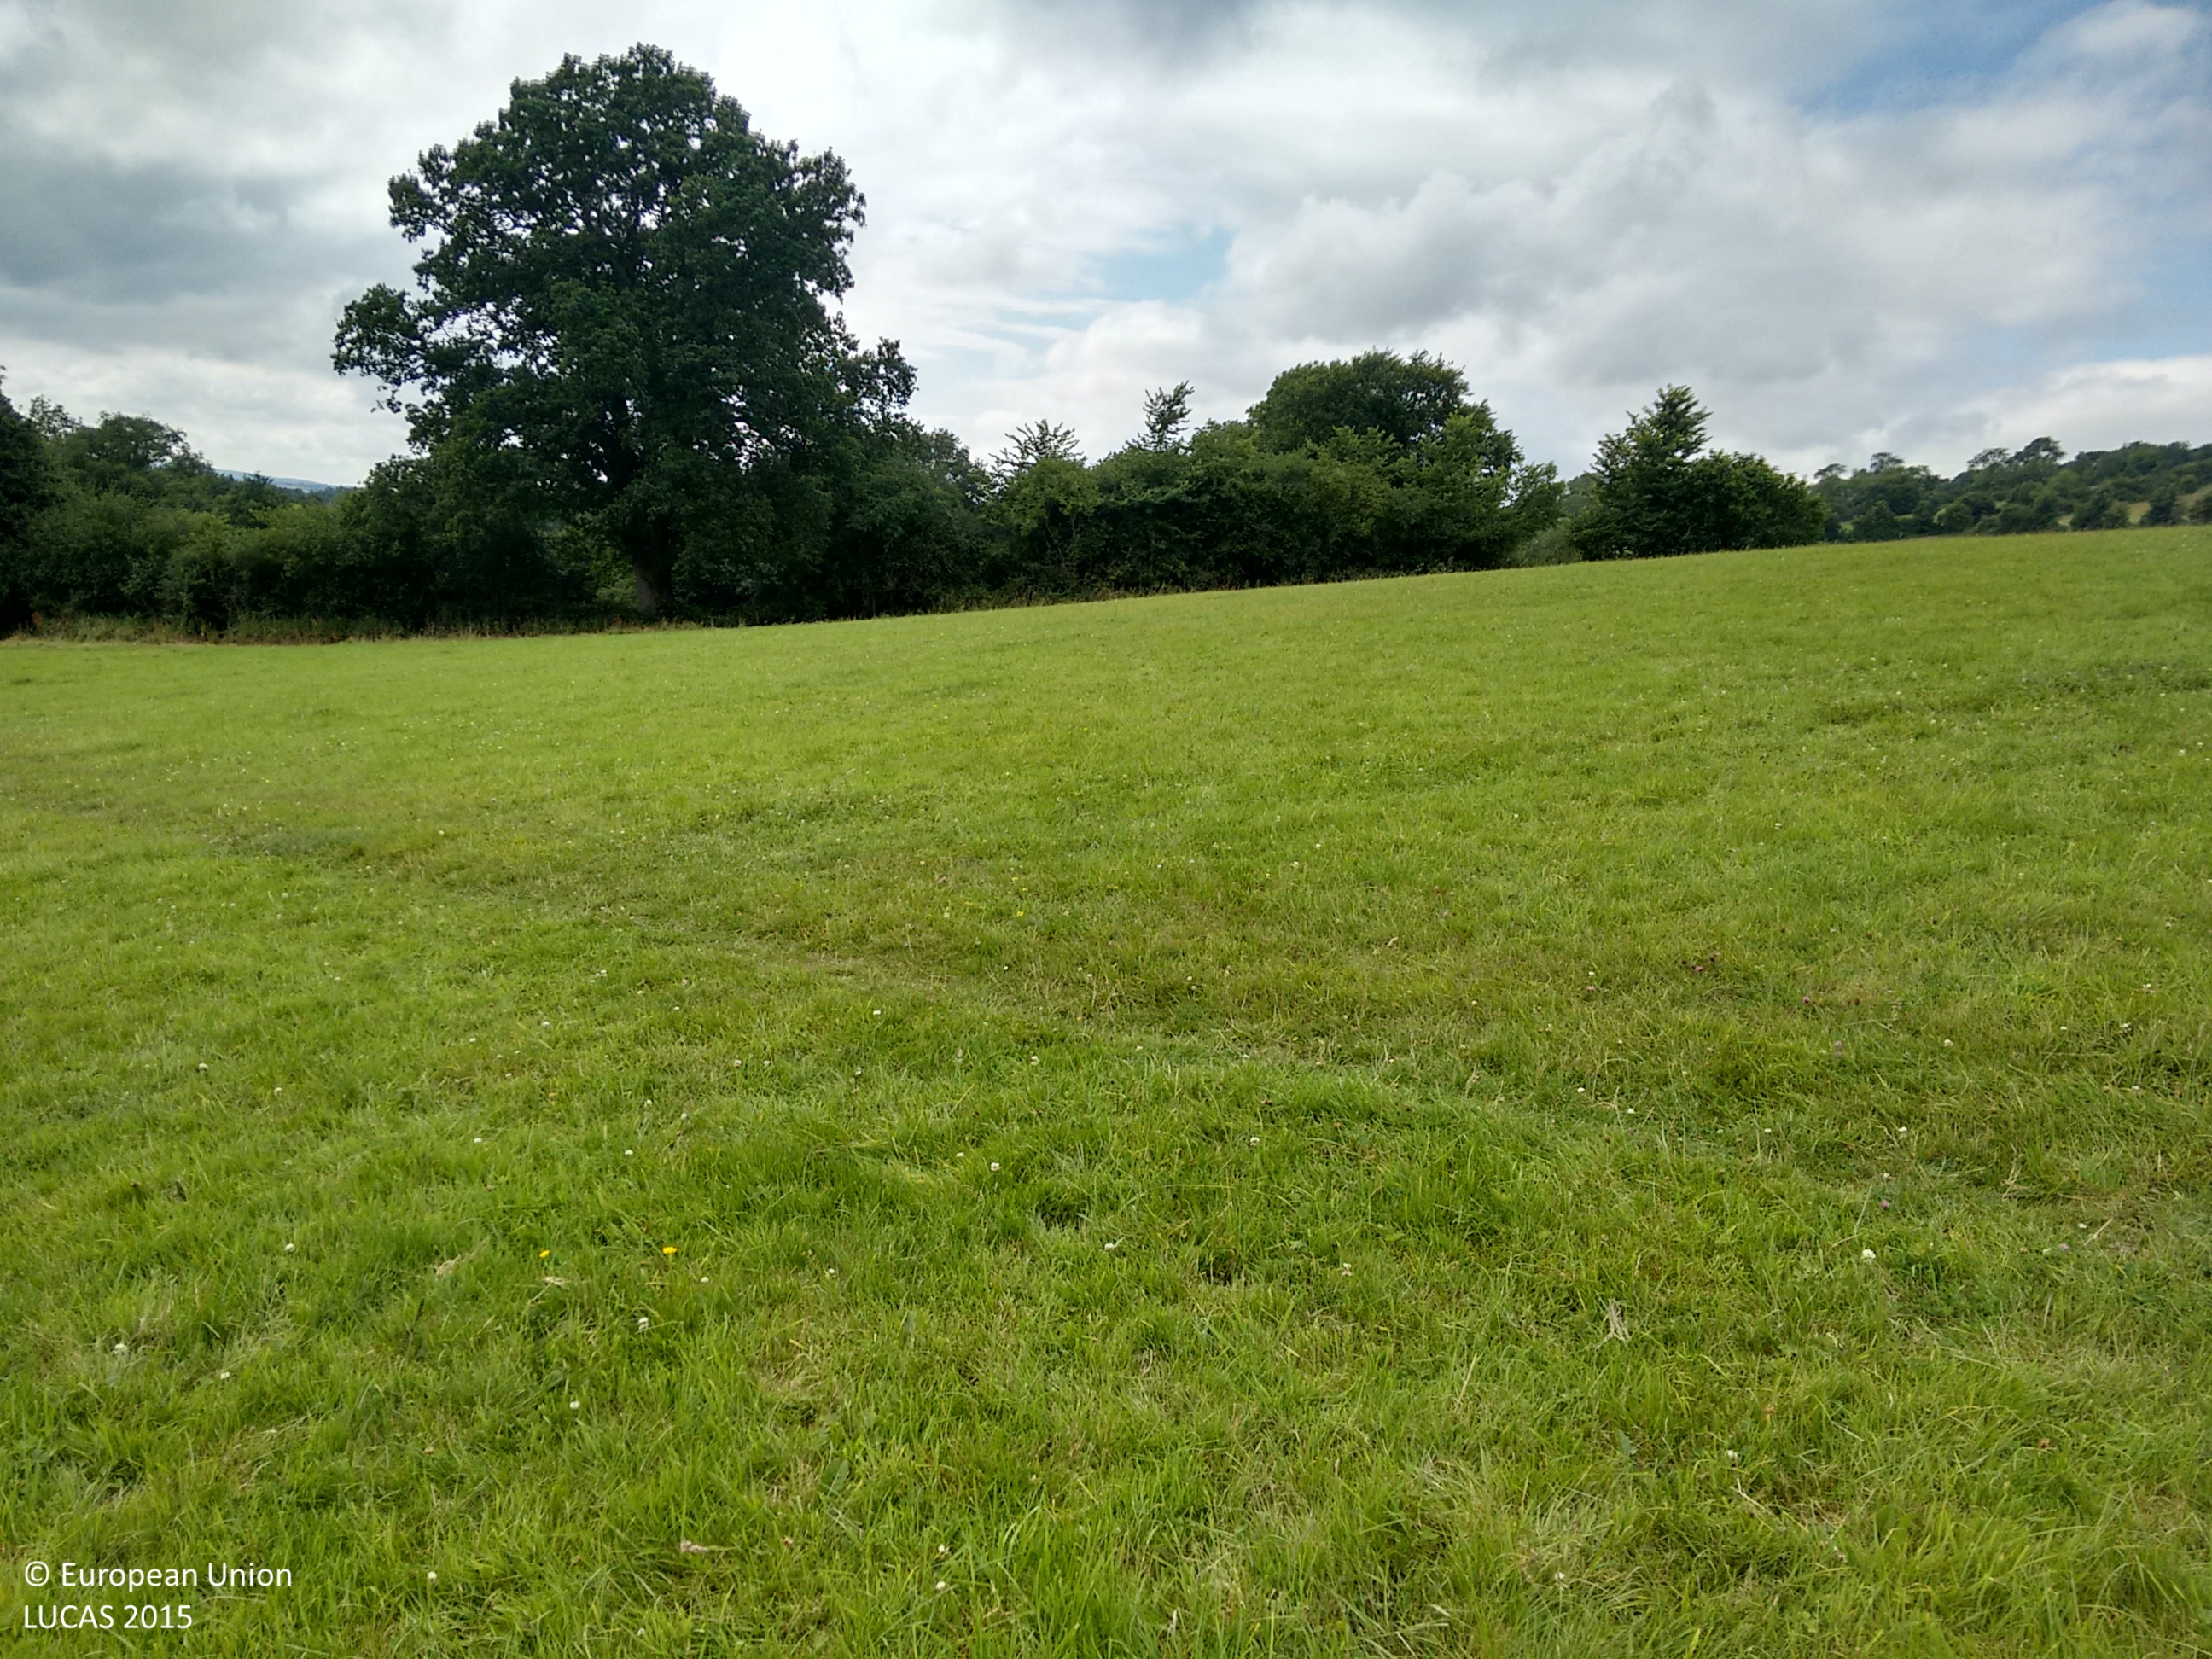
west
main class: Grassland
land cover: Grassland without tree/shrub cover
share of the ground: > 75 %
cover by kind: herbaceous plants 100 %
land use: Agriculture (excluding fallow land and kitchen gardens)
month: July
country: GB
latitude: 51.3832
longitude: -2.5245
